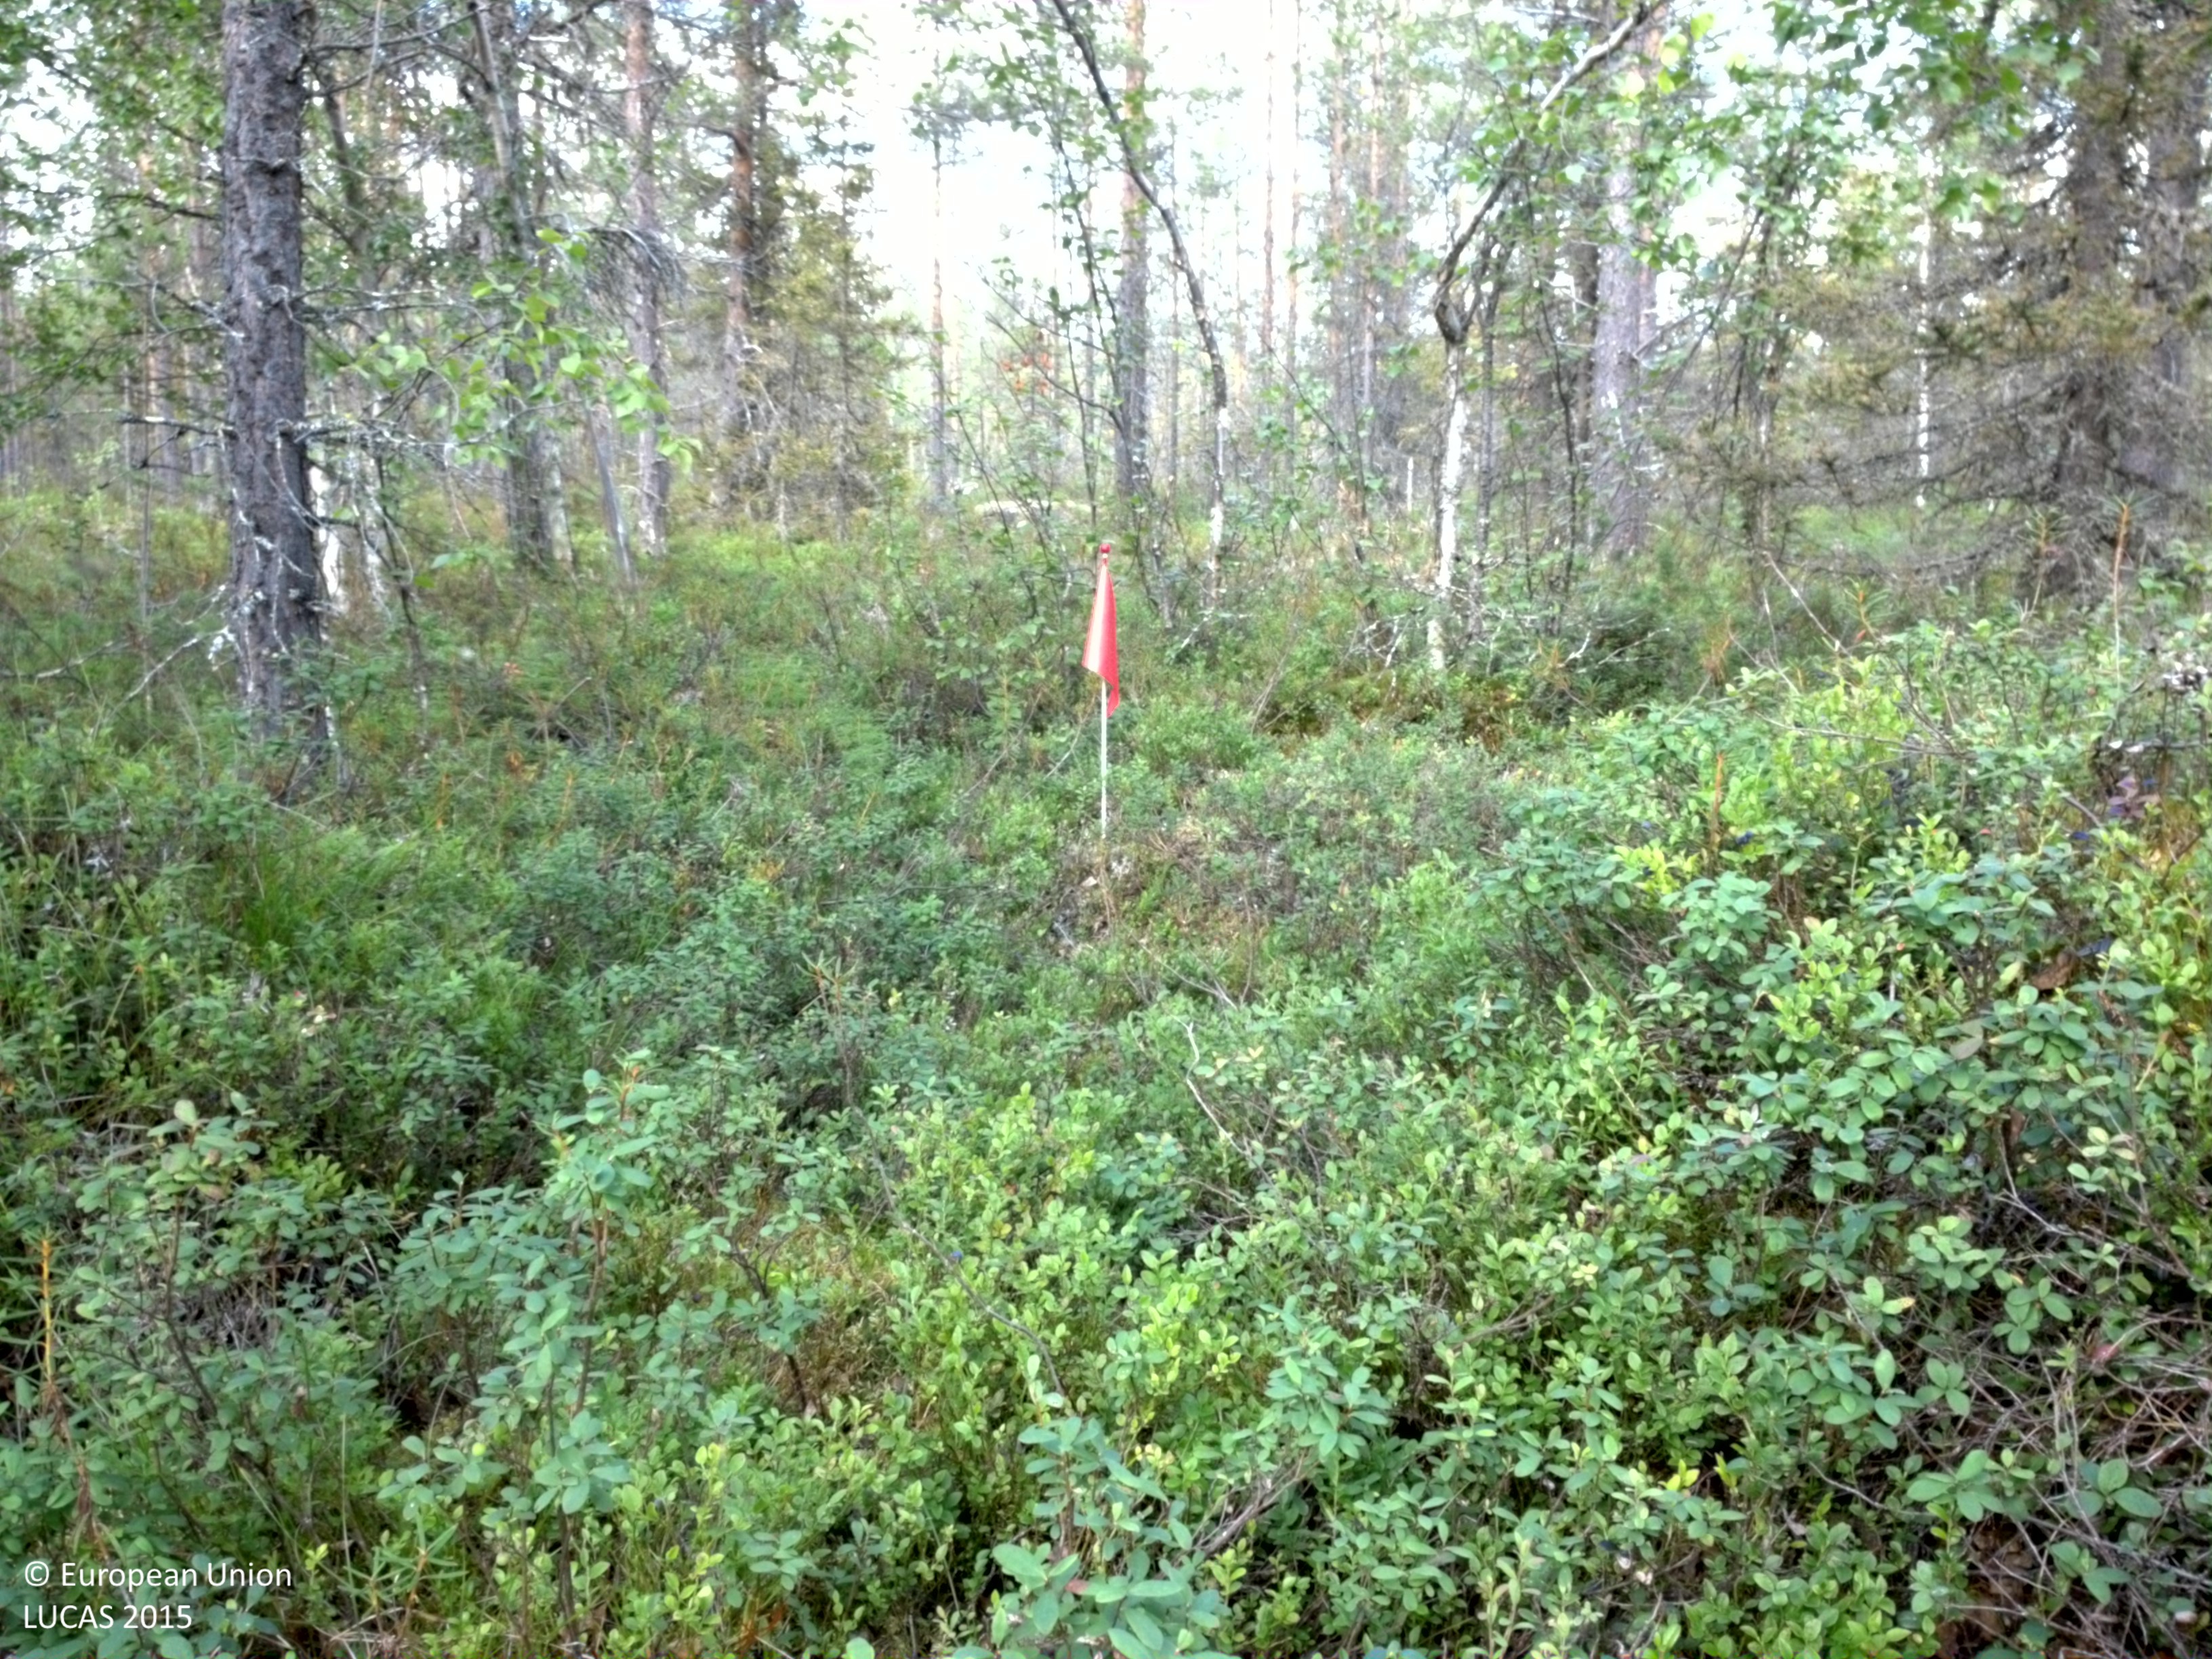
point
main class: Woodland
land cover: Pine dominated mixed woodland
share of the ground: 25 - 50 %
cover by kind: shrubs 60 %, coniferous forest trees 25 %, broadleaved forest trees 10 %, lichens and mosses 5 %
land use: Forestry
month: August
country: SE
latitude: 66.4247
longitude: 20.7809
